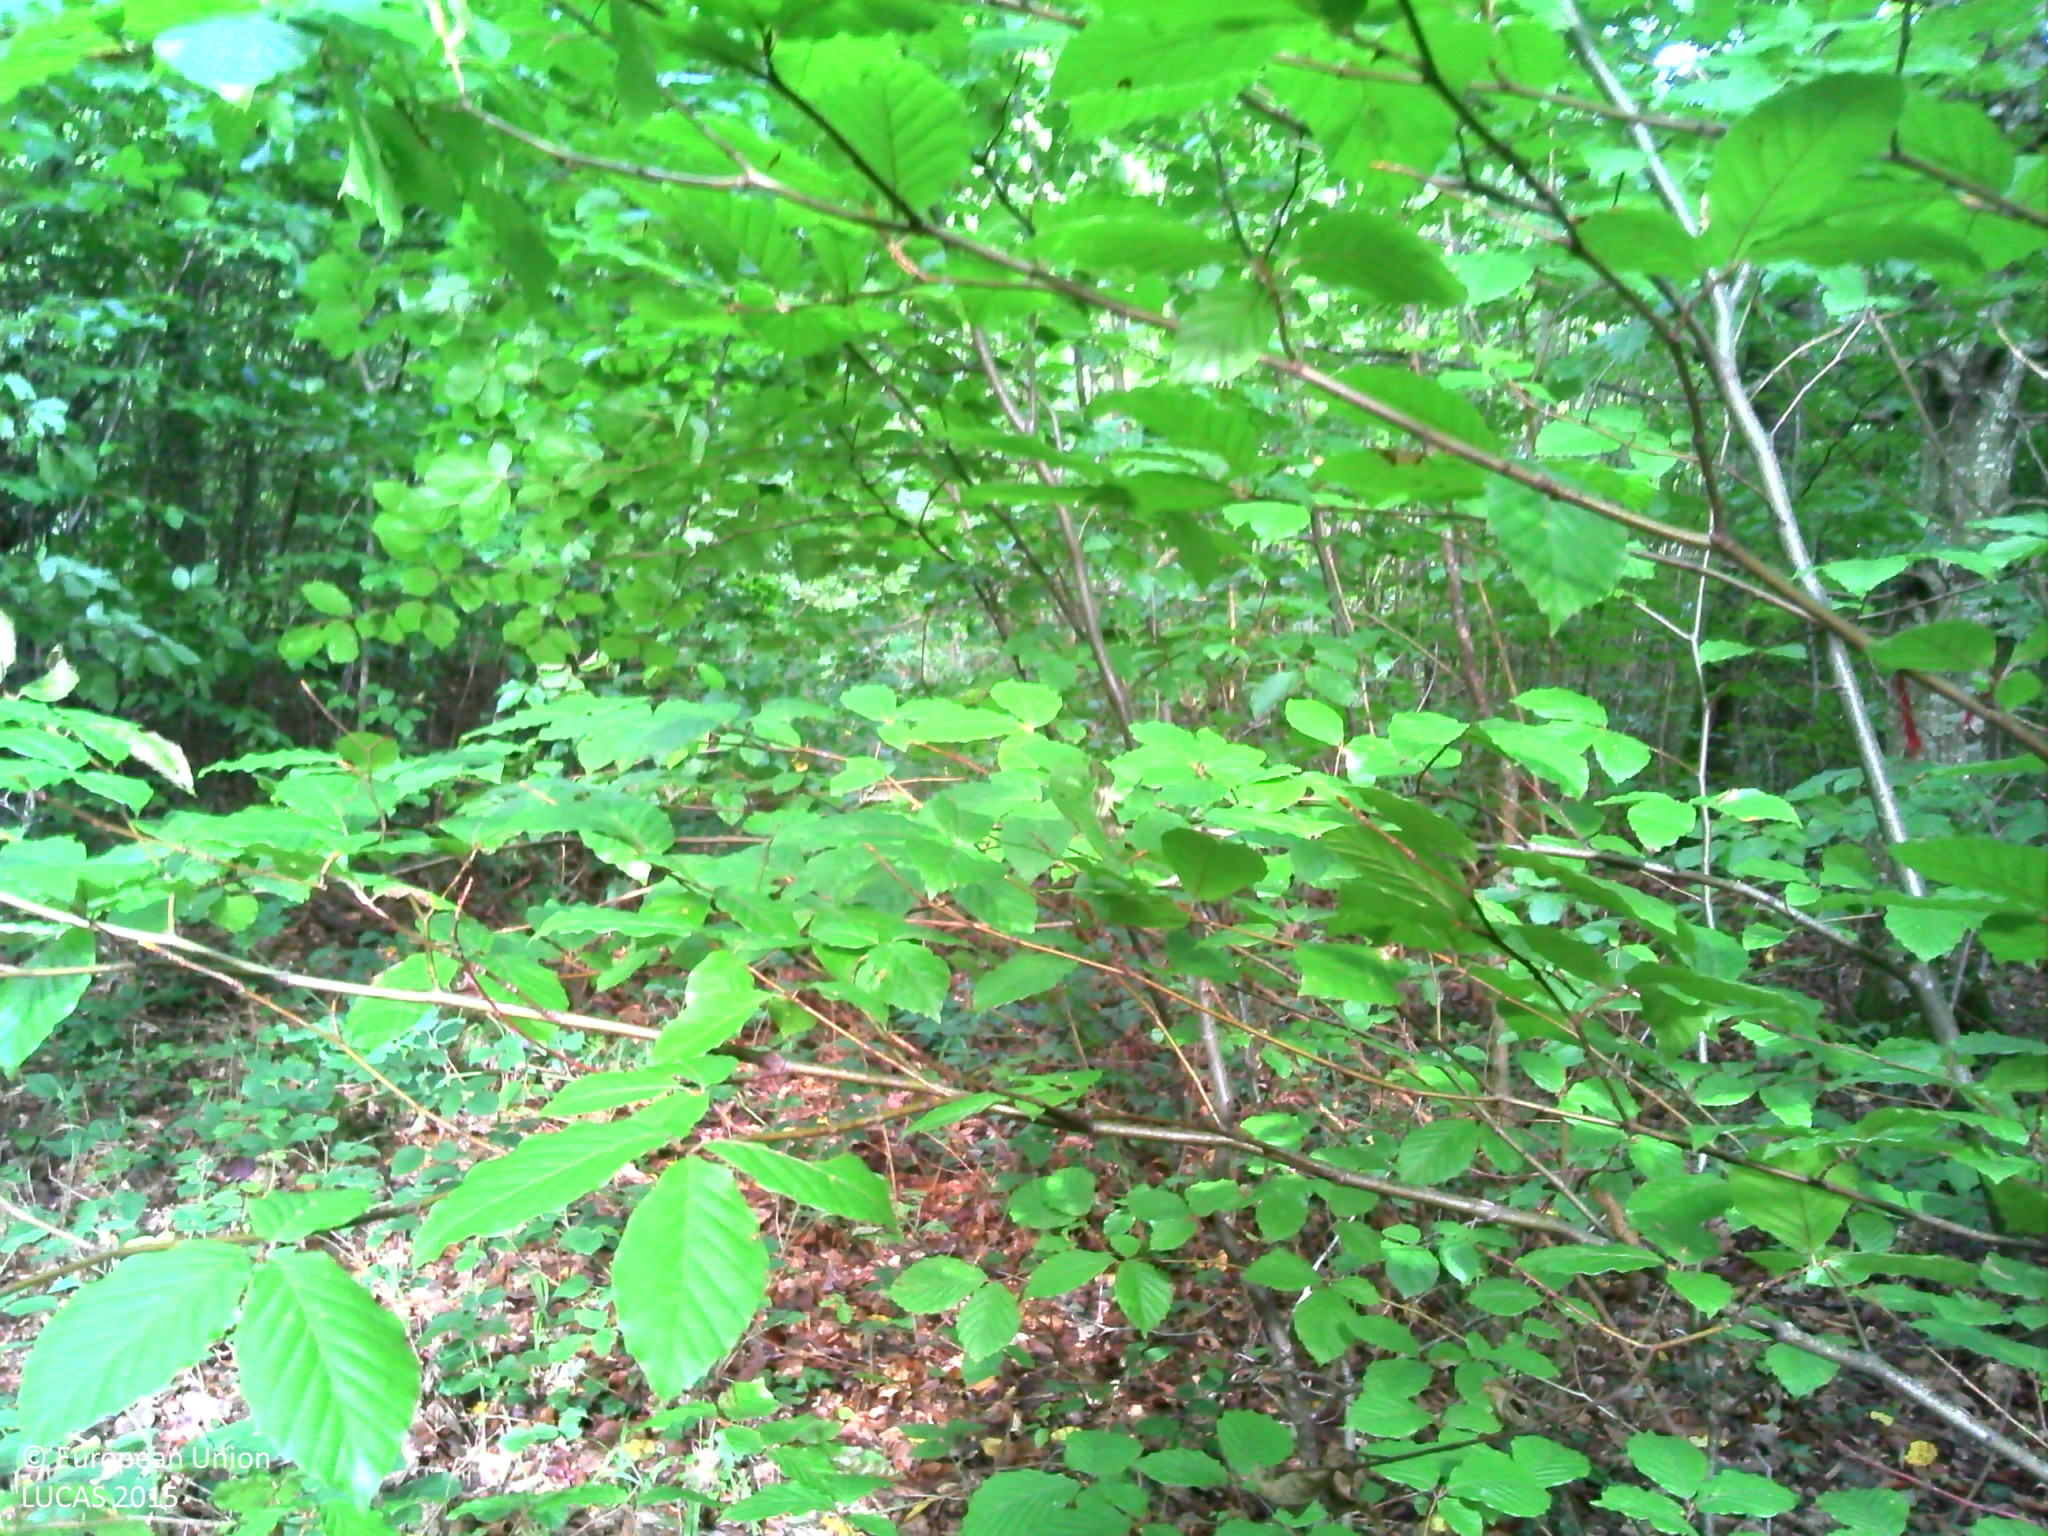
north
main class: Woodland
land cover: Broadleaved woodland
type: mesophytic deciduous forest
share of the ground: > 75 %
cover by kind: broadleaved forest trees 90 %, herbaceous plants 5 %, consolidated bare surface 5 %
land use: Forestry
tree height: > 5 m
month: September
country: FR
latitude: 48.8538
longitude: 6.0064
